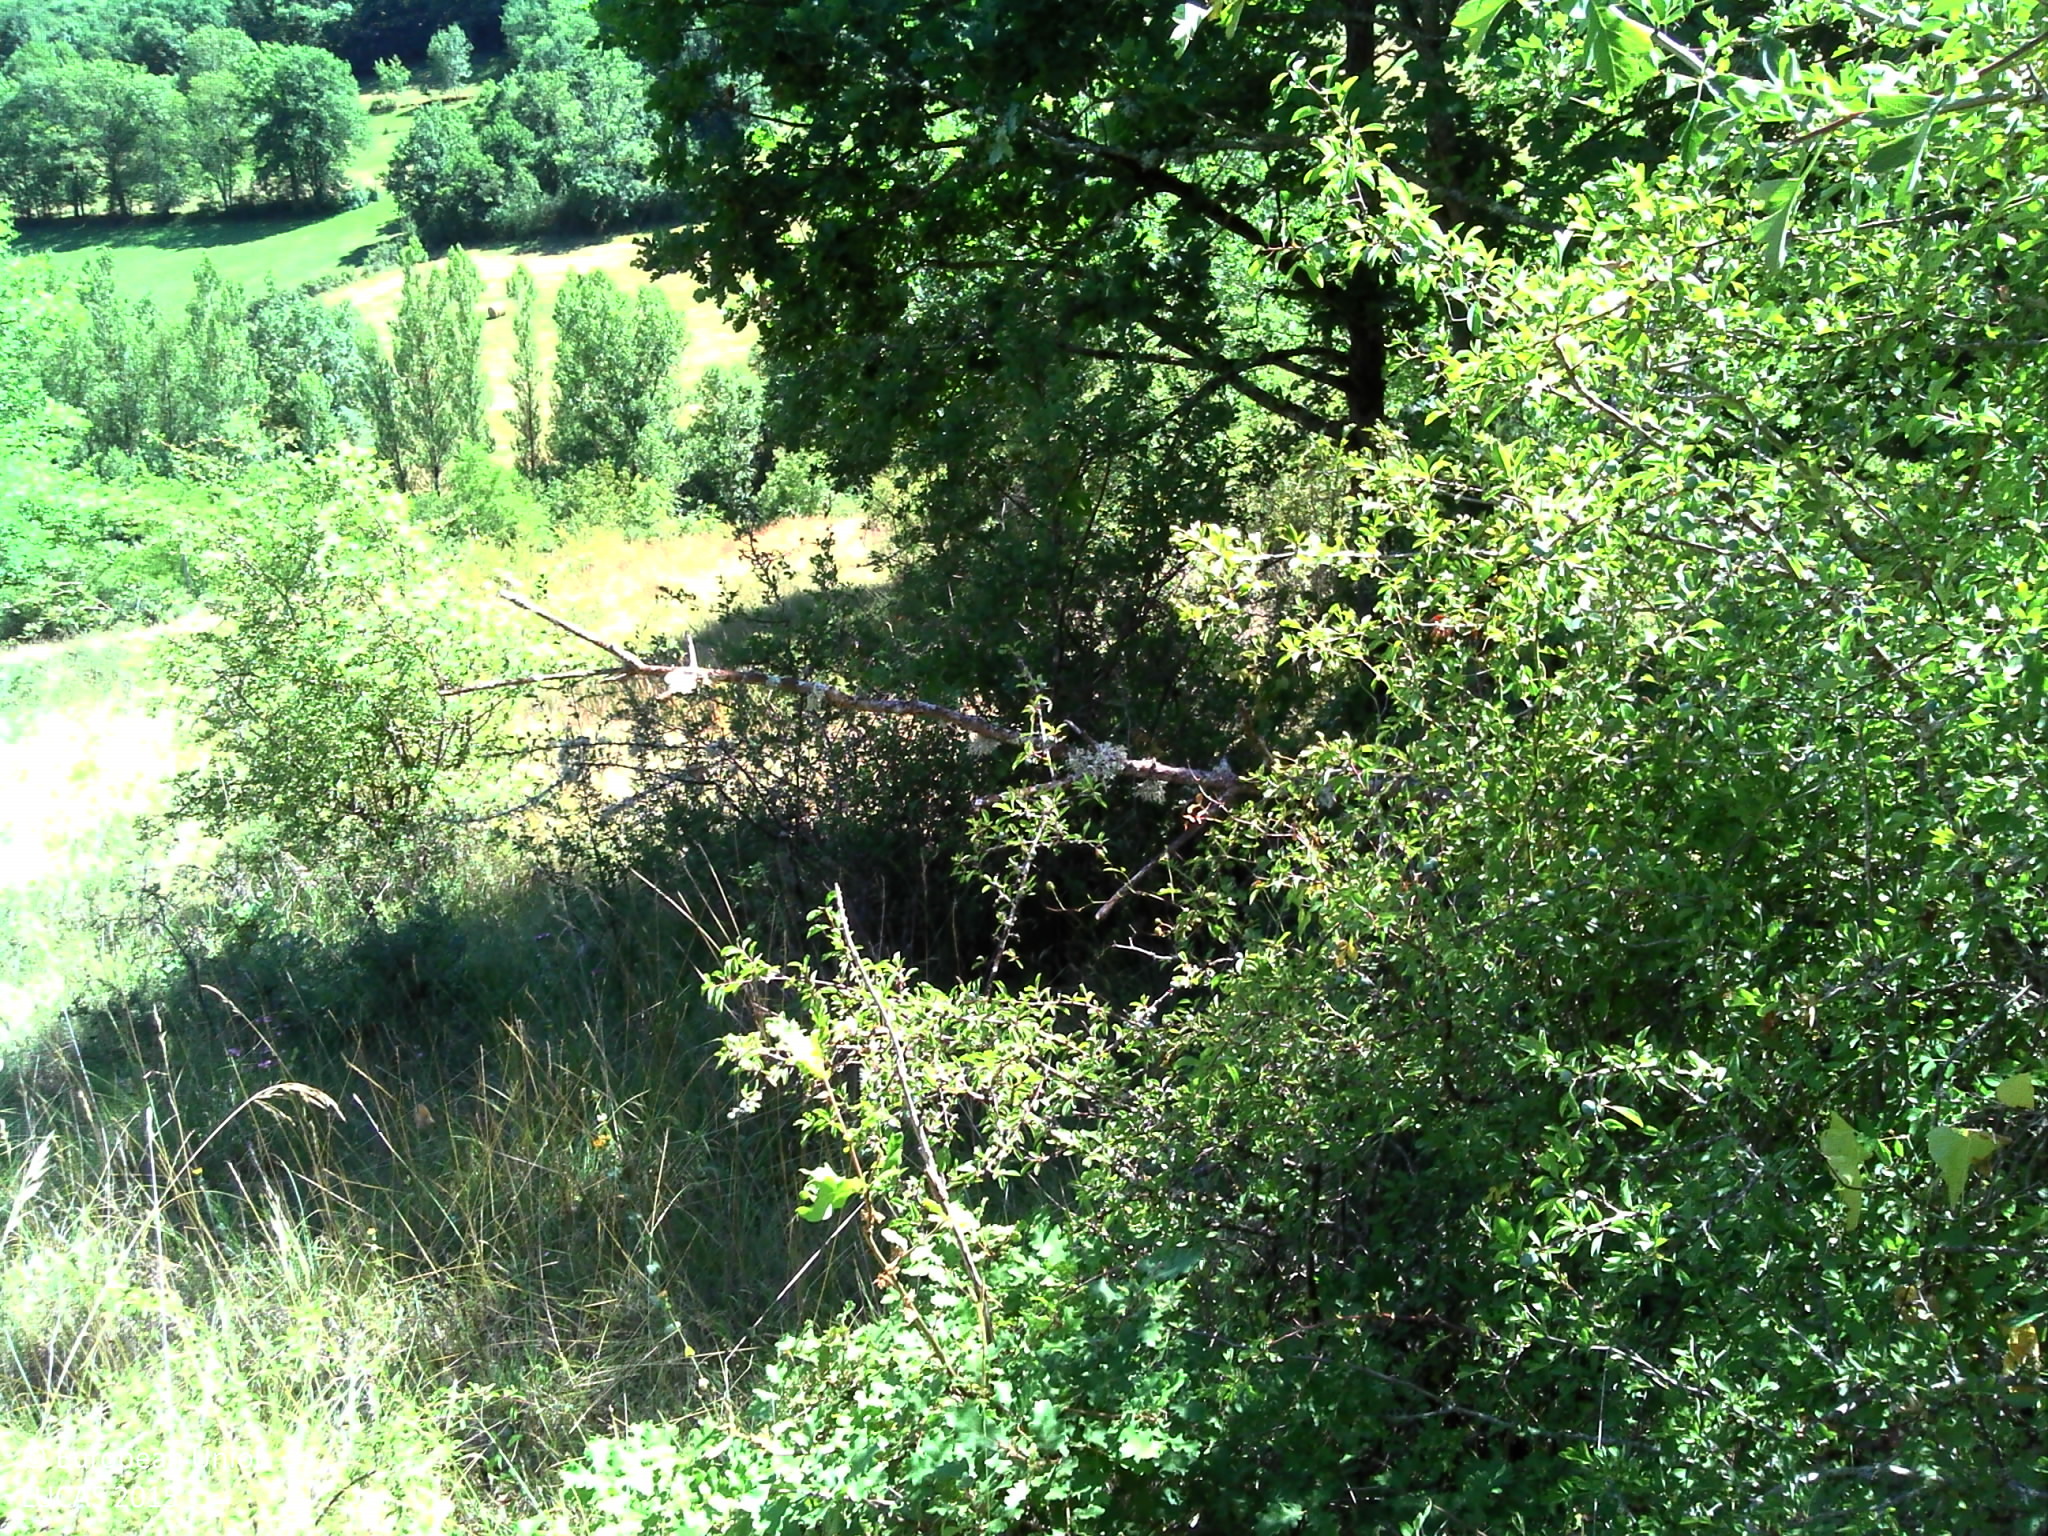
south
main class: Shrubland
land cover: Shrubland with sparse tree cover
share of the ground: > 75 %
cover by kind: shrubs 95 %, broadleaved forest trees 5 %
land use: Agriculture (excluding fallow land and kitchen gardens)
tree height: > 5 m
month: June
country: FR
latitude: 44.4734
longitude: 2.4471
